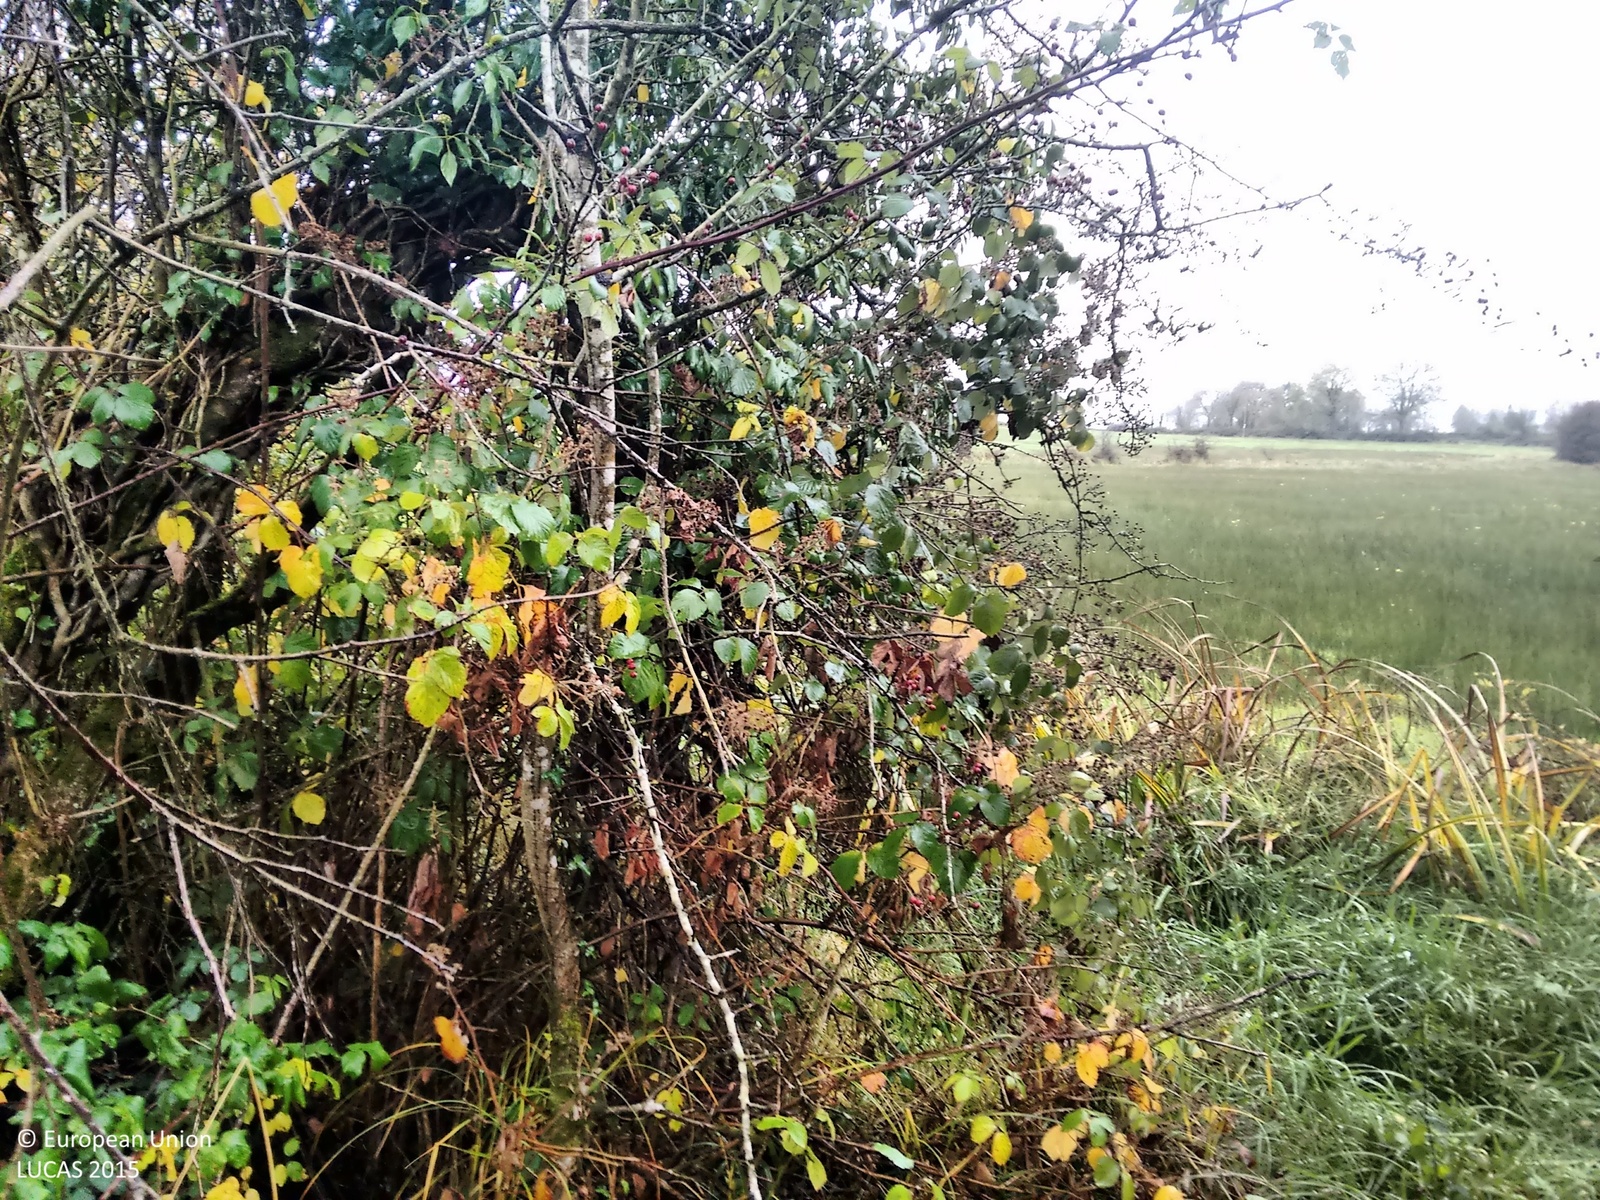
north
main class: Grassland
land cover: Grassland without tree/shrub cover
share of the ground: > 75 %
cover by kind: herbaceous plants 100 %
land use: Agriculture (excluding fallow land and kitchen gardens)
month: October
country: IE
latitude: 53.8833
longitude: -8.1148
